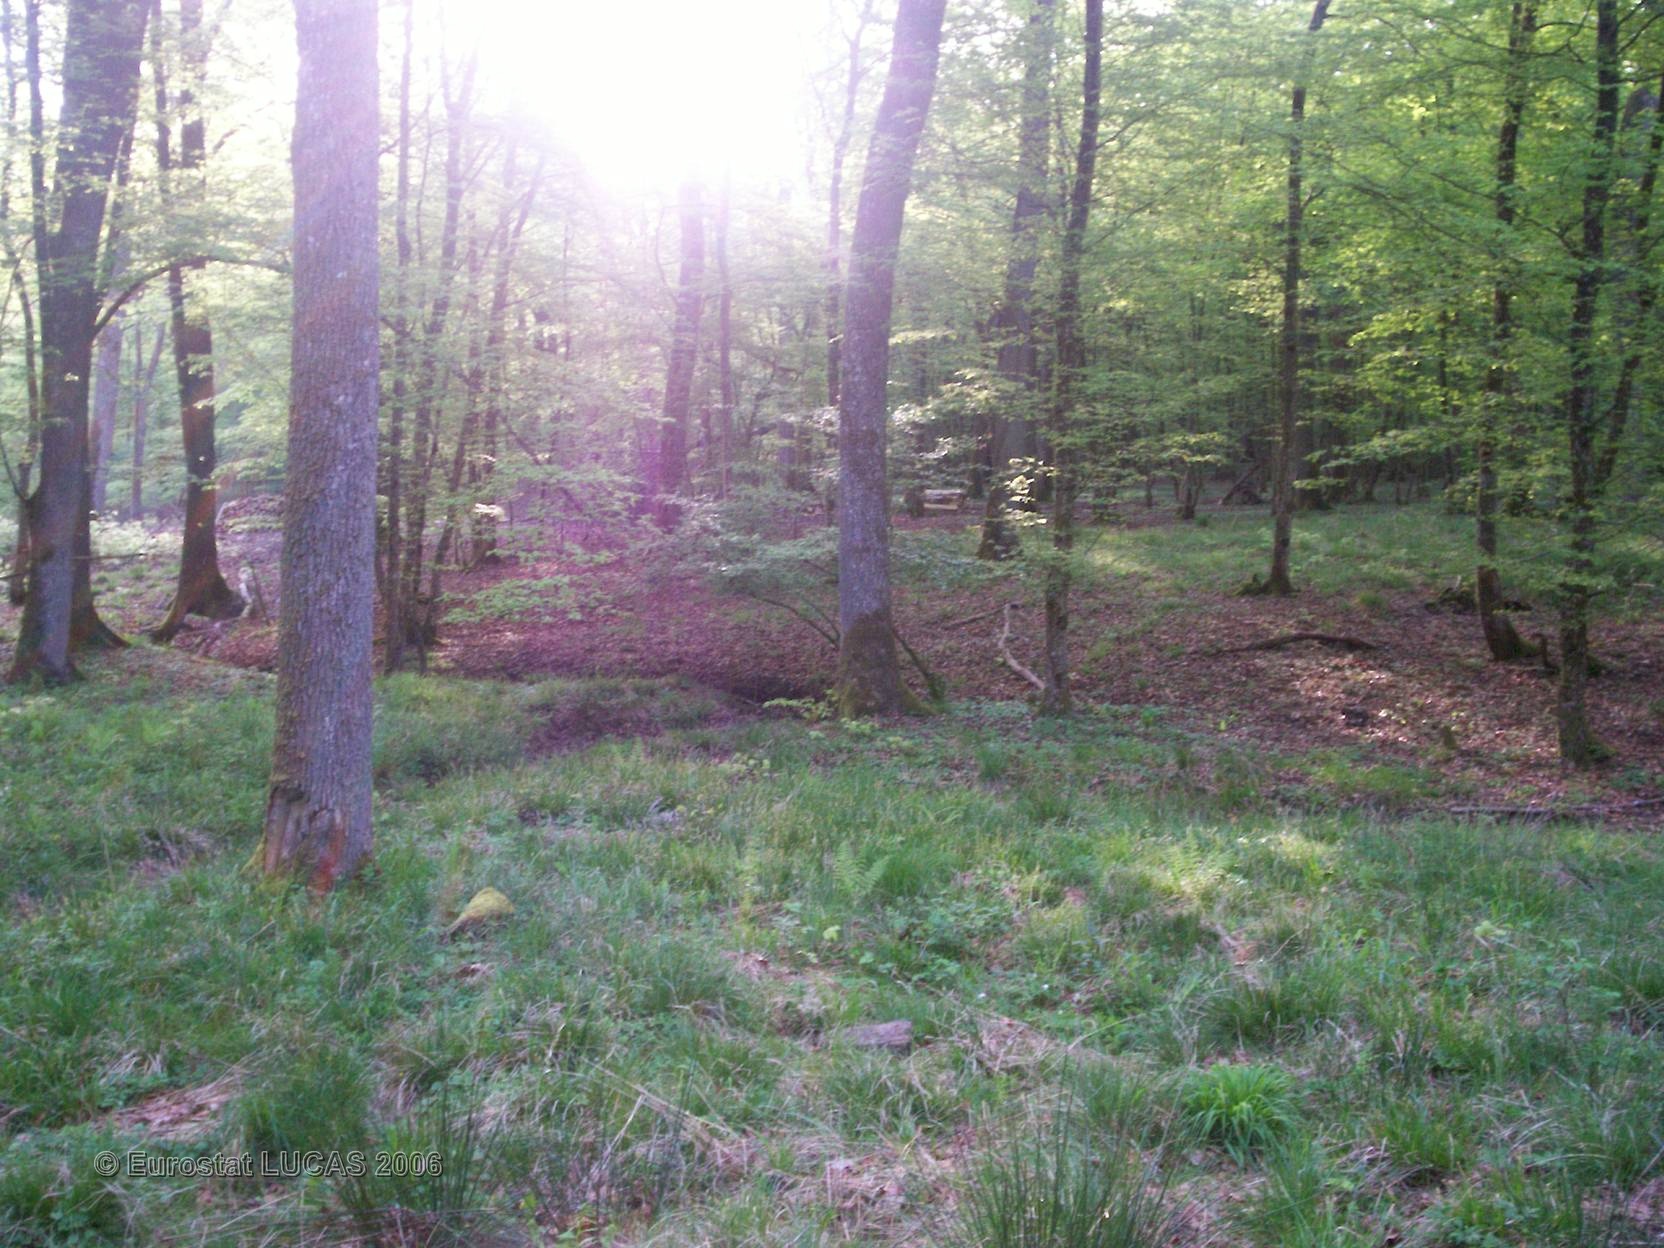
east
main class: Woodland
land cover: Broadleaved forest
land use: Forestry
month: May
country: FR
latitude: 48.9744
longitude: 6.9812
